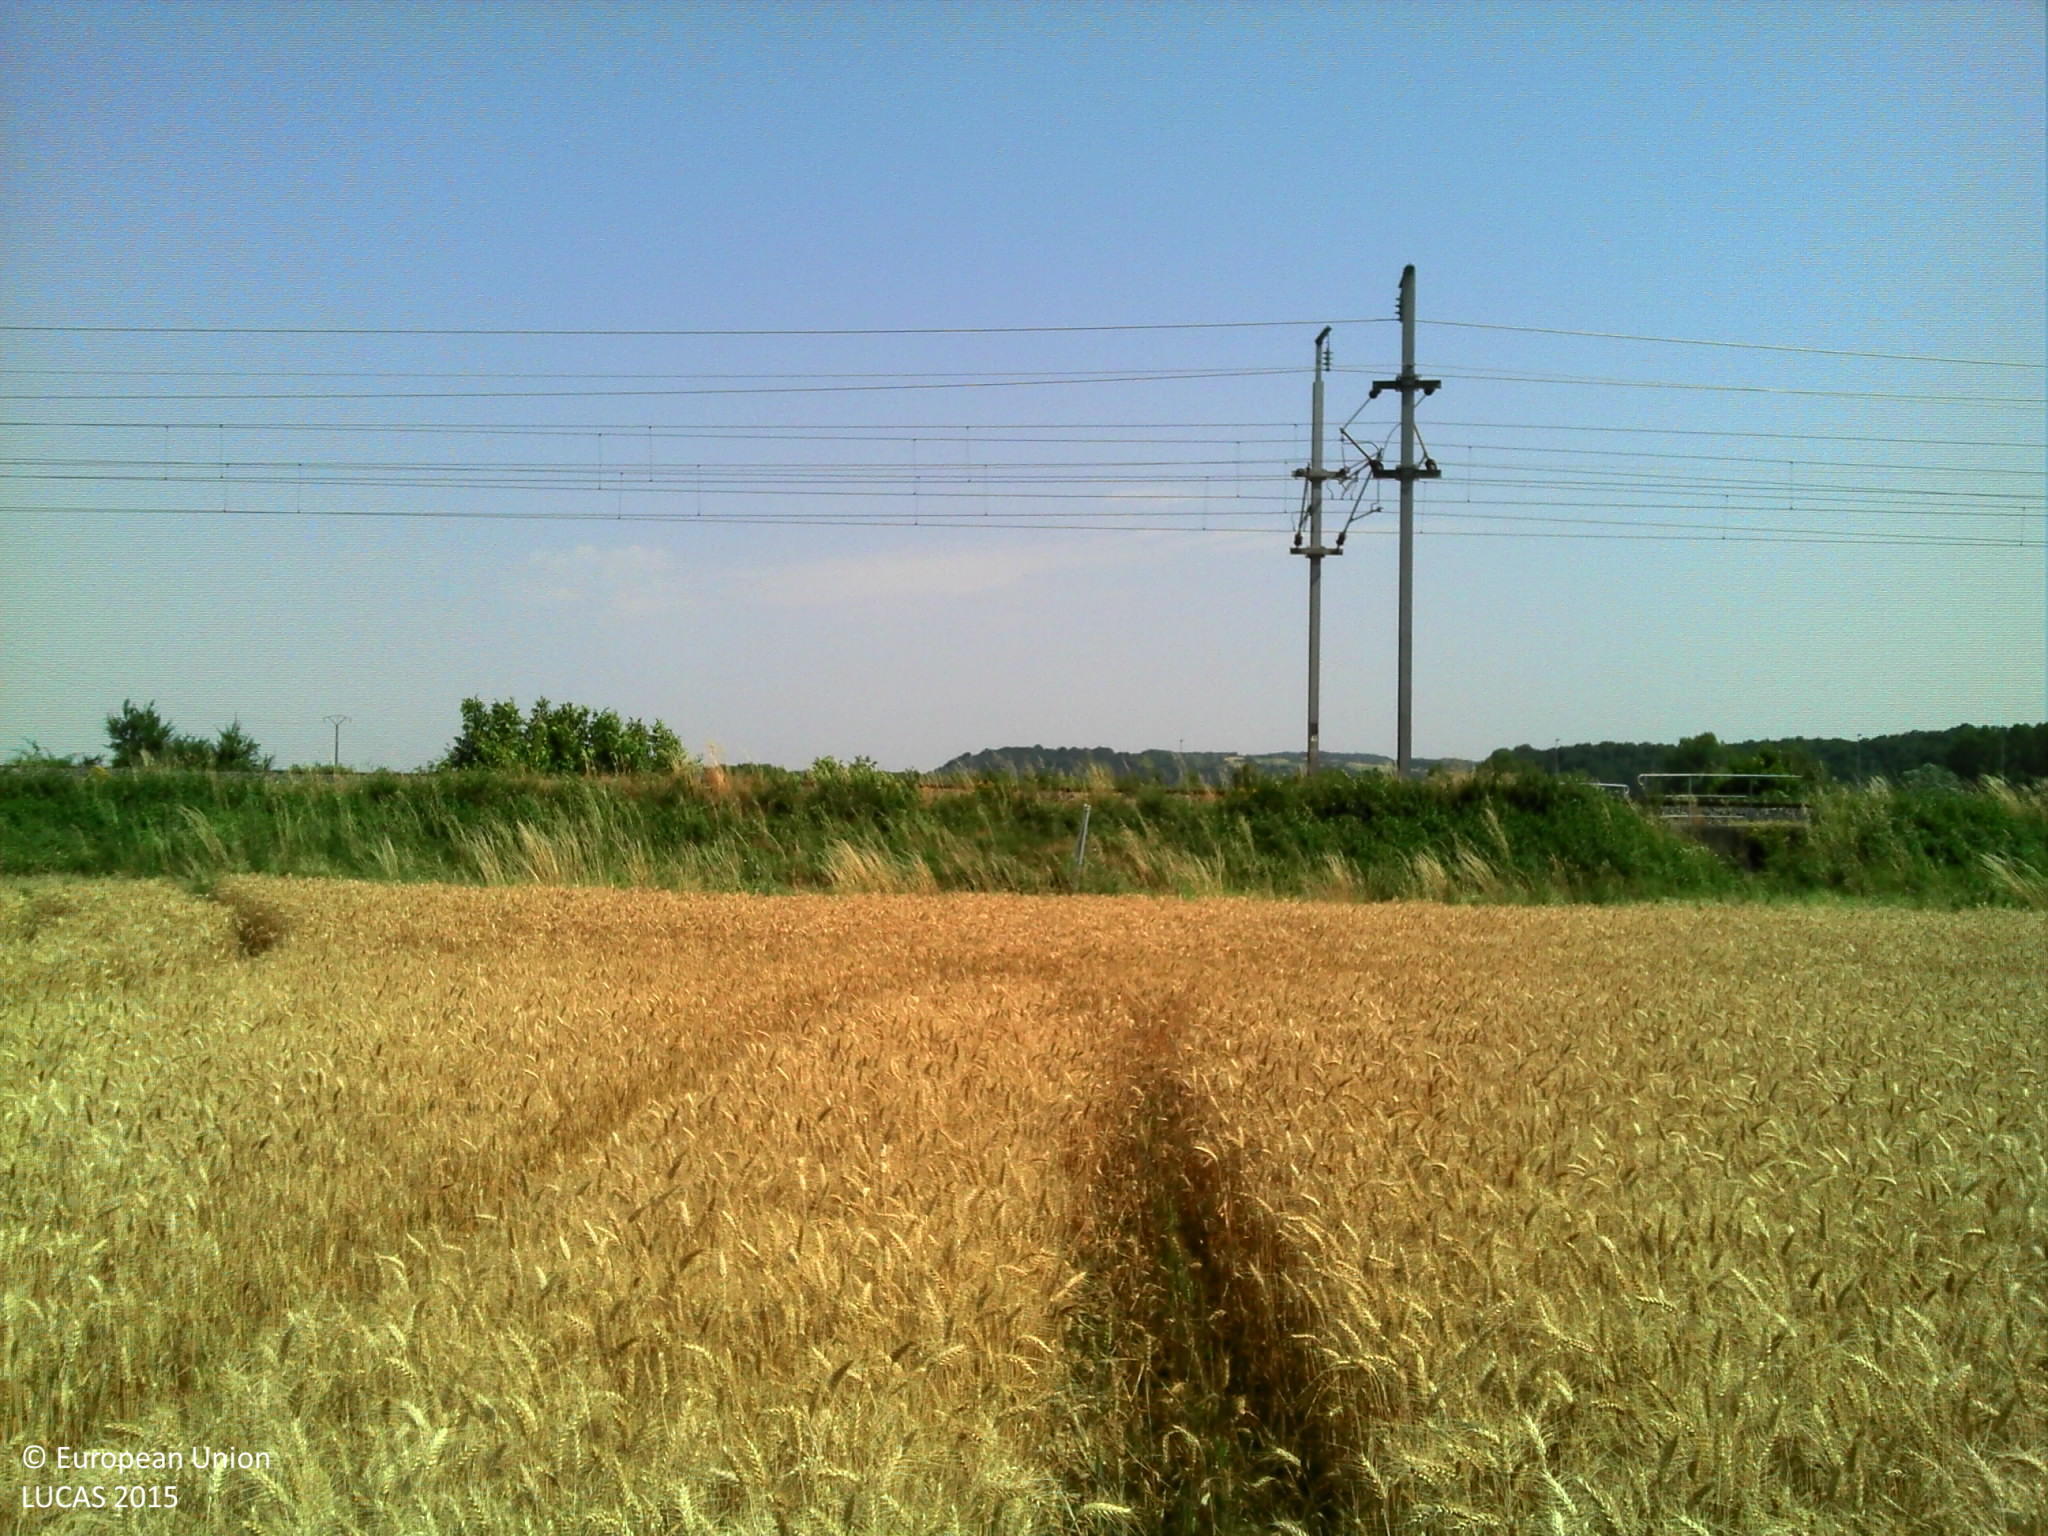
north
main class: Cropland
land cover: Durum wheat
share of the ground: > 75 %
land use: Agriculture (excluding fallow land and kitchen gardens)
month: July
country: FR
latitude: 45.6117
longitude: 5.1956
